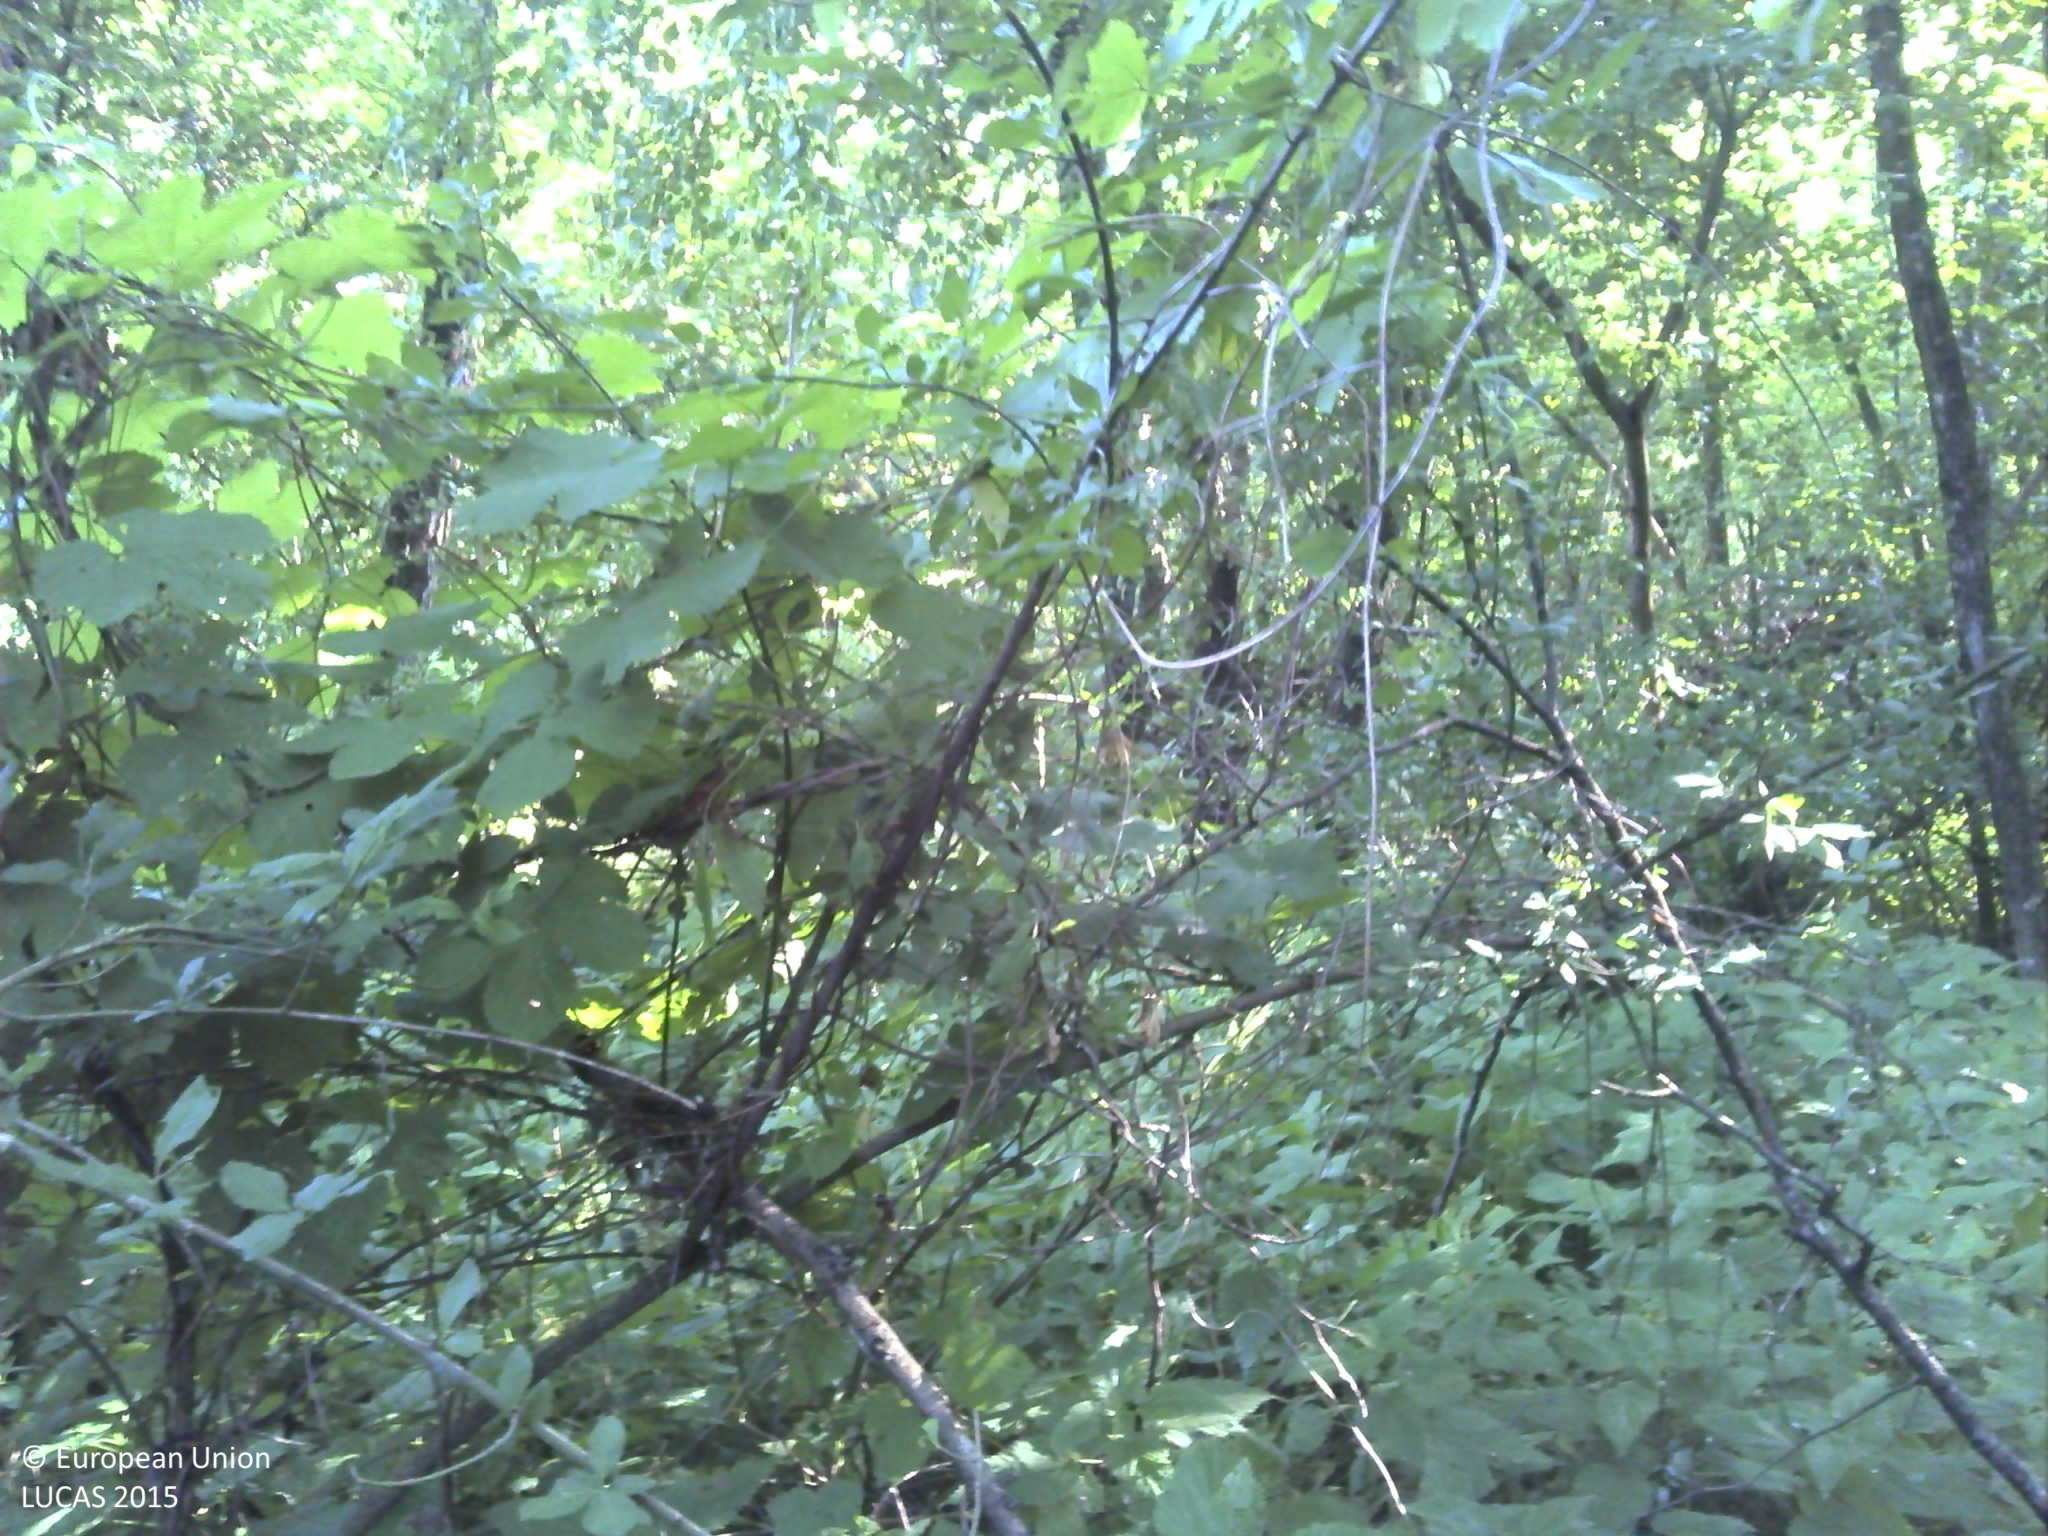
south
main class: Woodland
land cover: Broadleaved woodland
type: beech forest
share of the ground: > 75 %
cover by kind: broadleaved forest trees 80 %, lichens and mosses 20 %
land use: Forestry
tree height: > 5 m
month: June
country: HR
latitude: 45.4967
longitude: 17.1536
